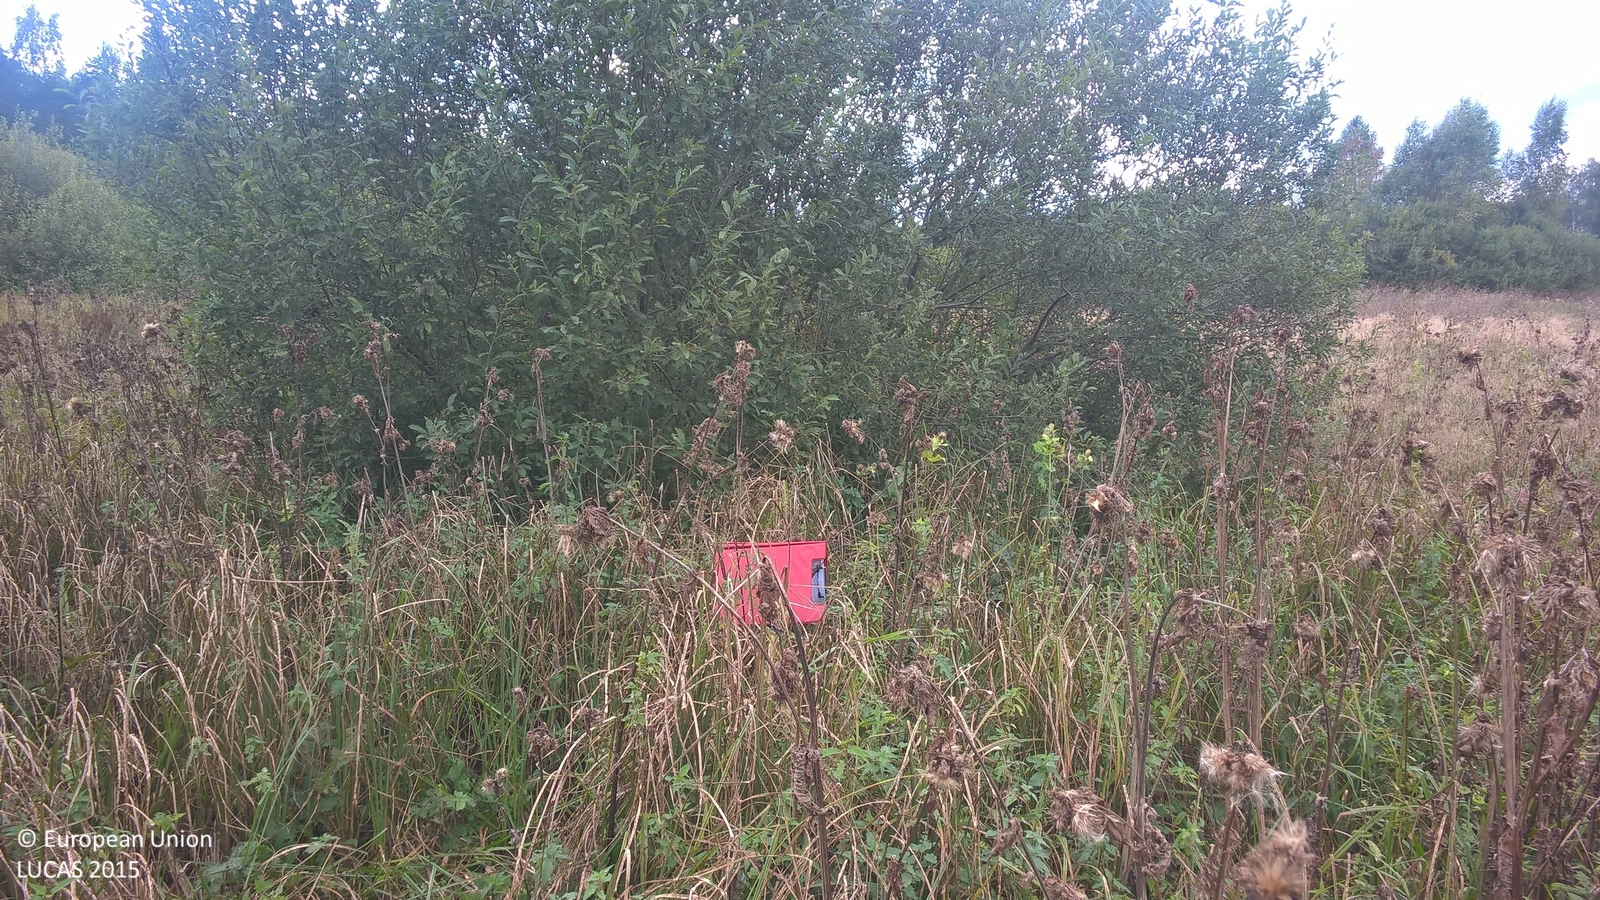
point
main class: Grassland
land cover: Spontaneously vegetated surfaces
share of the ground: > 75 %
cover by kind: herbaceous plants 95 %, shrubs 5 %
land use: Semi-natural and natural areas not in use
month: September
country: LV
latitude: 57.7172
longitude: 25.6456
